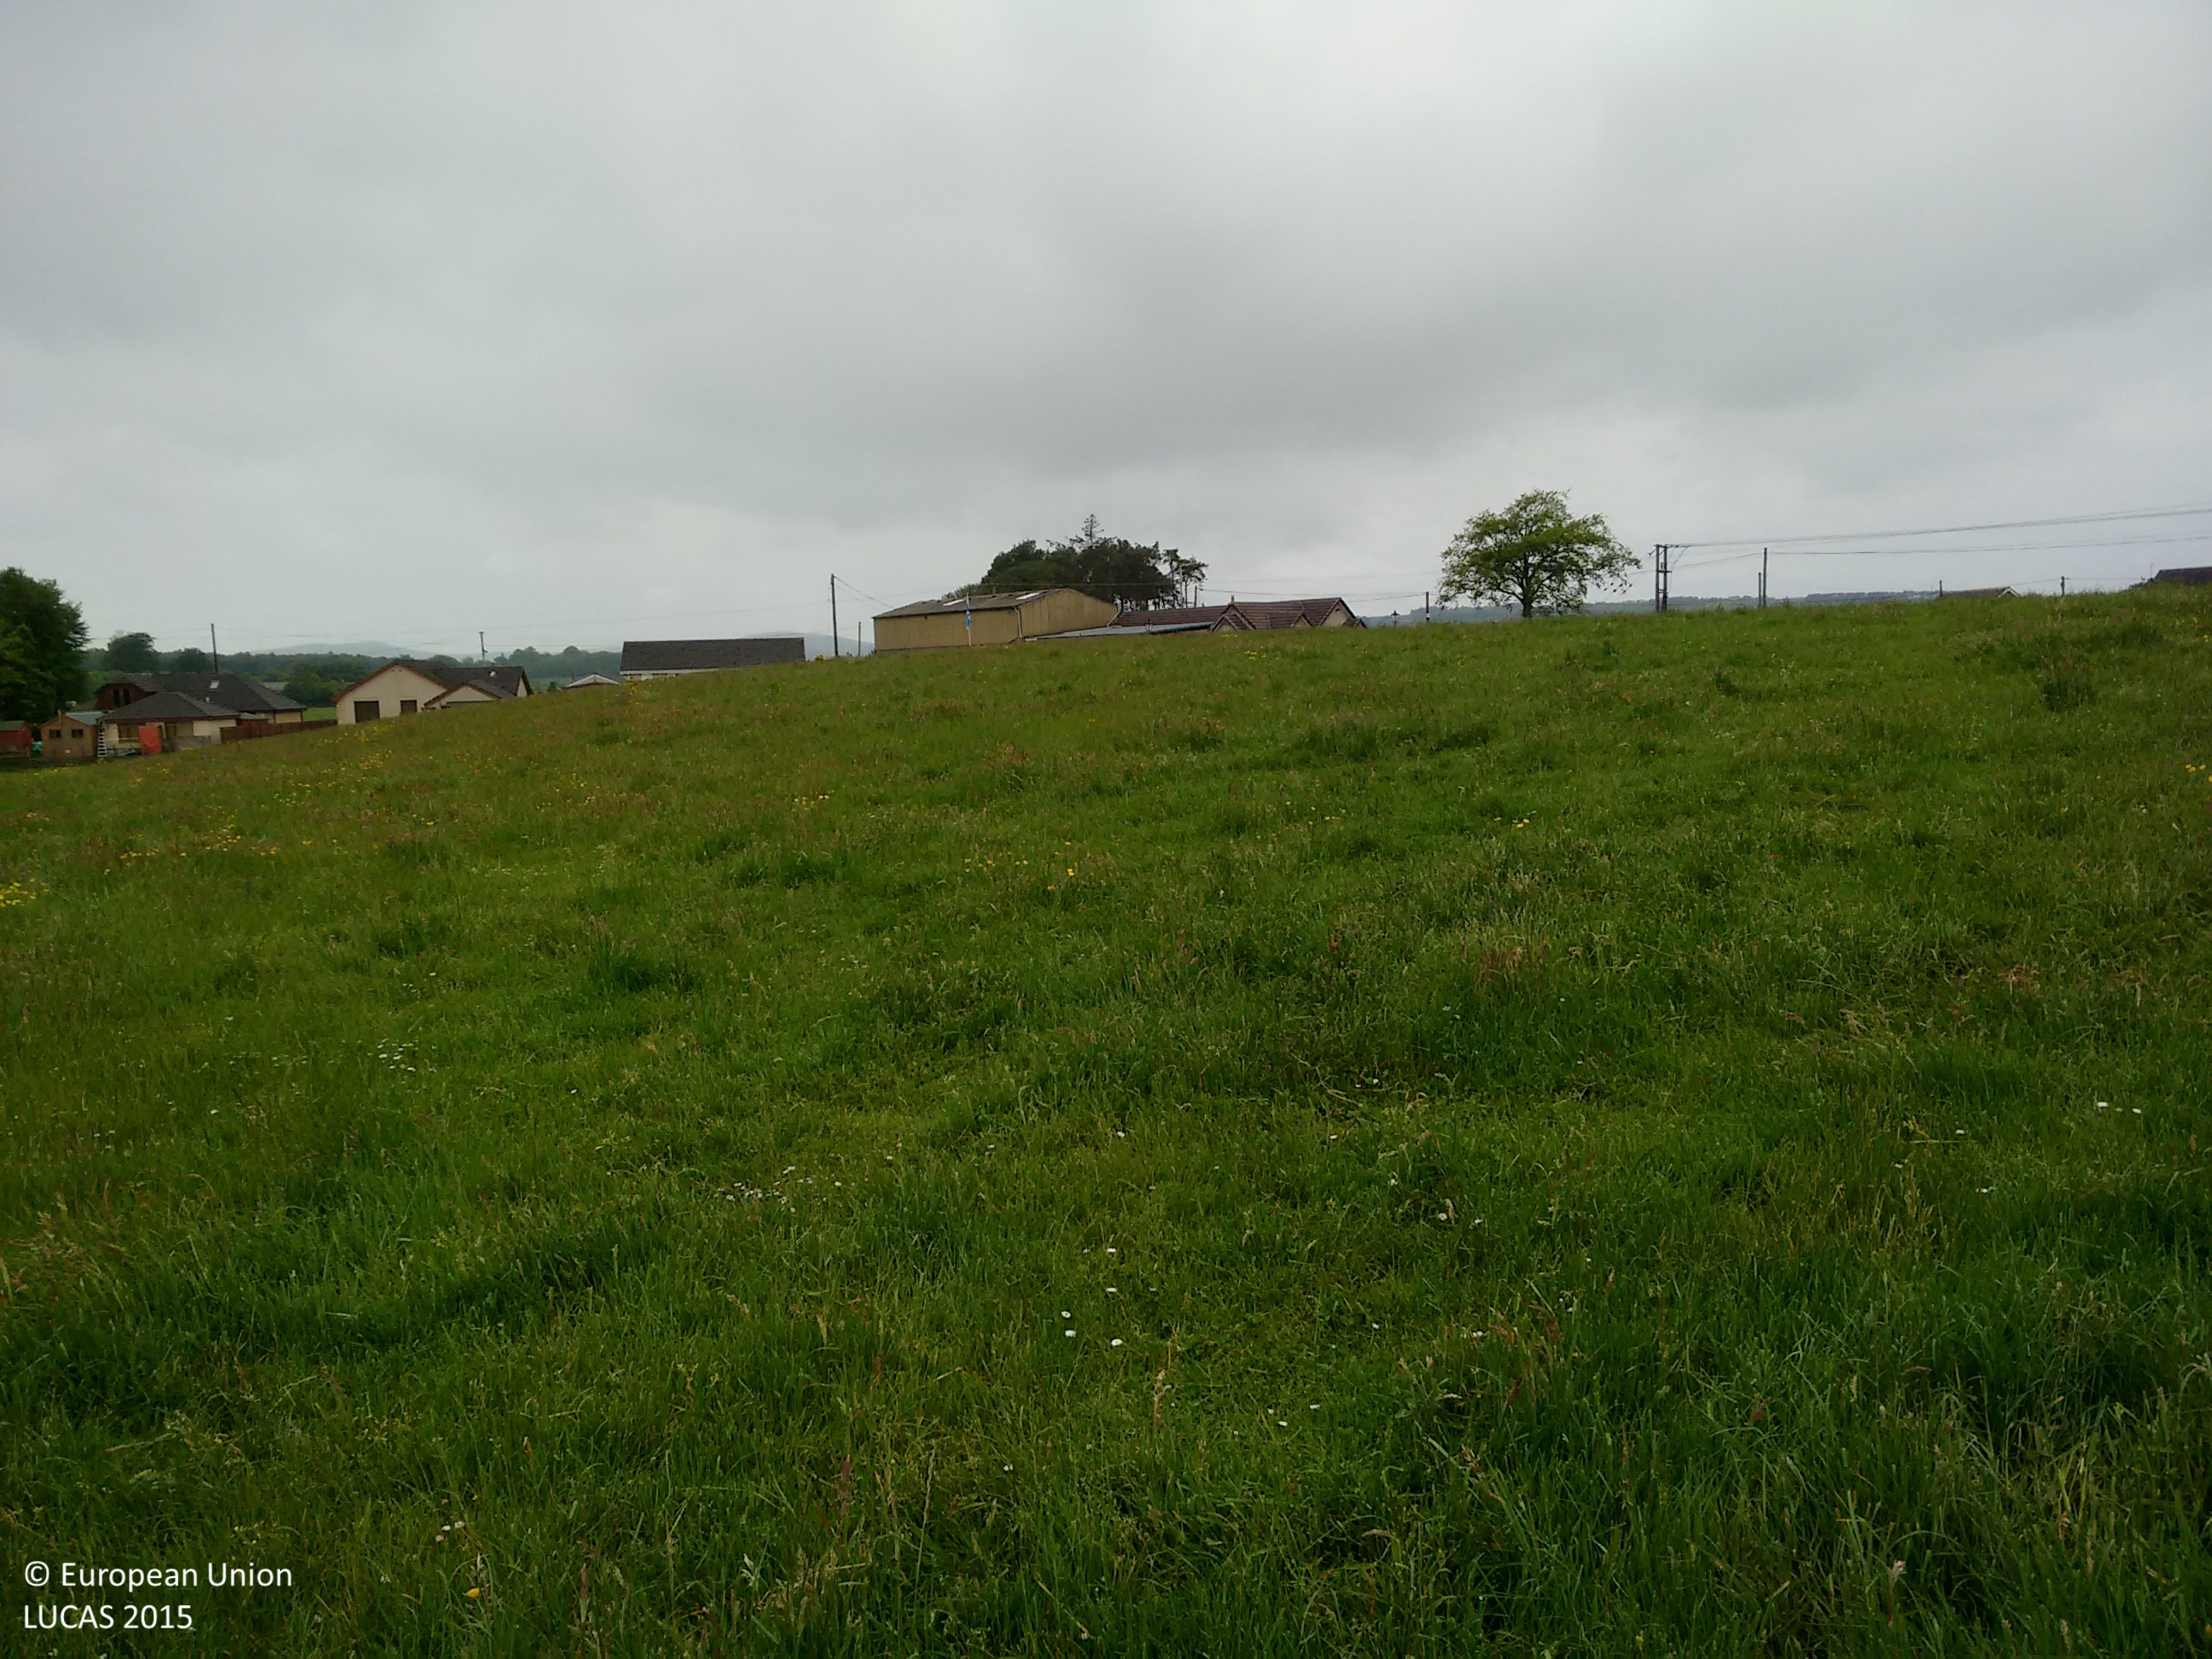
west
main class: Grassland
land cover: Grassland without tree/shrub cover
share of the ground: > 75 %
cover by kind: herbaceous plants 100 %
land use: Agriculture (excluding fallow land and kitchen gardens)
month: June
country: GB
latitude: 55.6319
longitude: -3.8571
